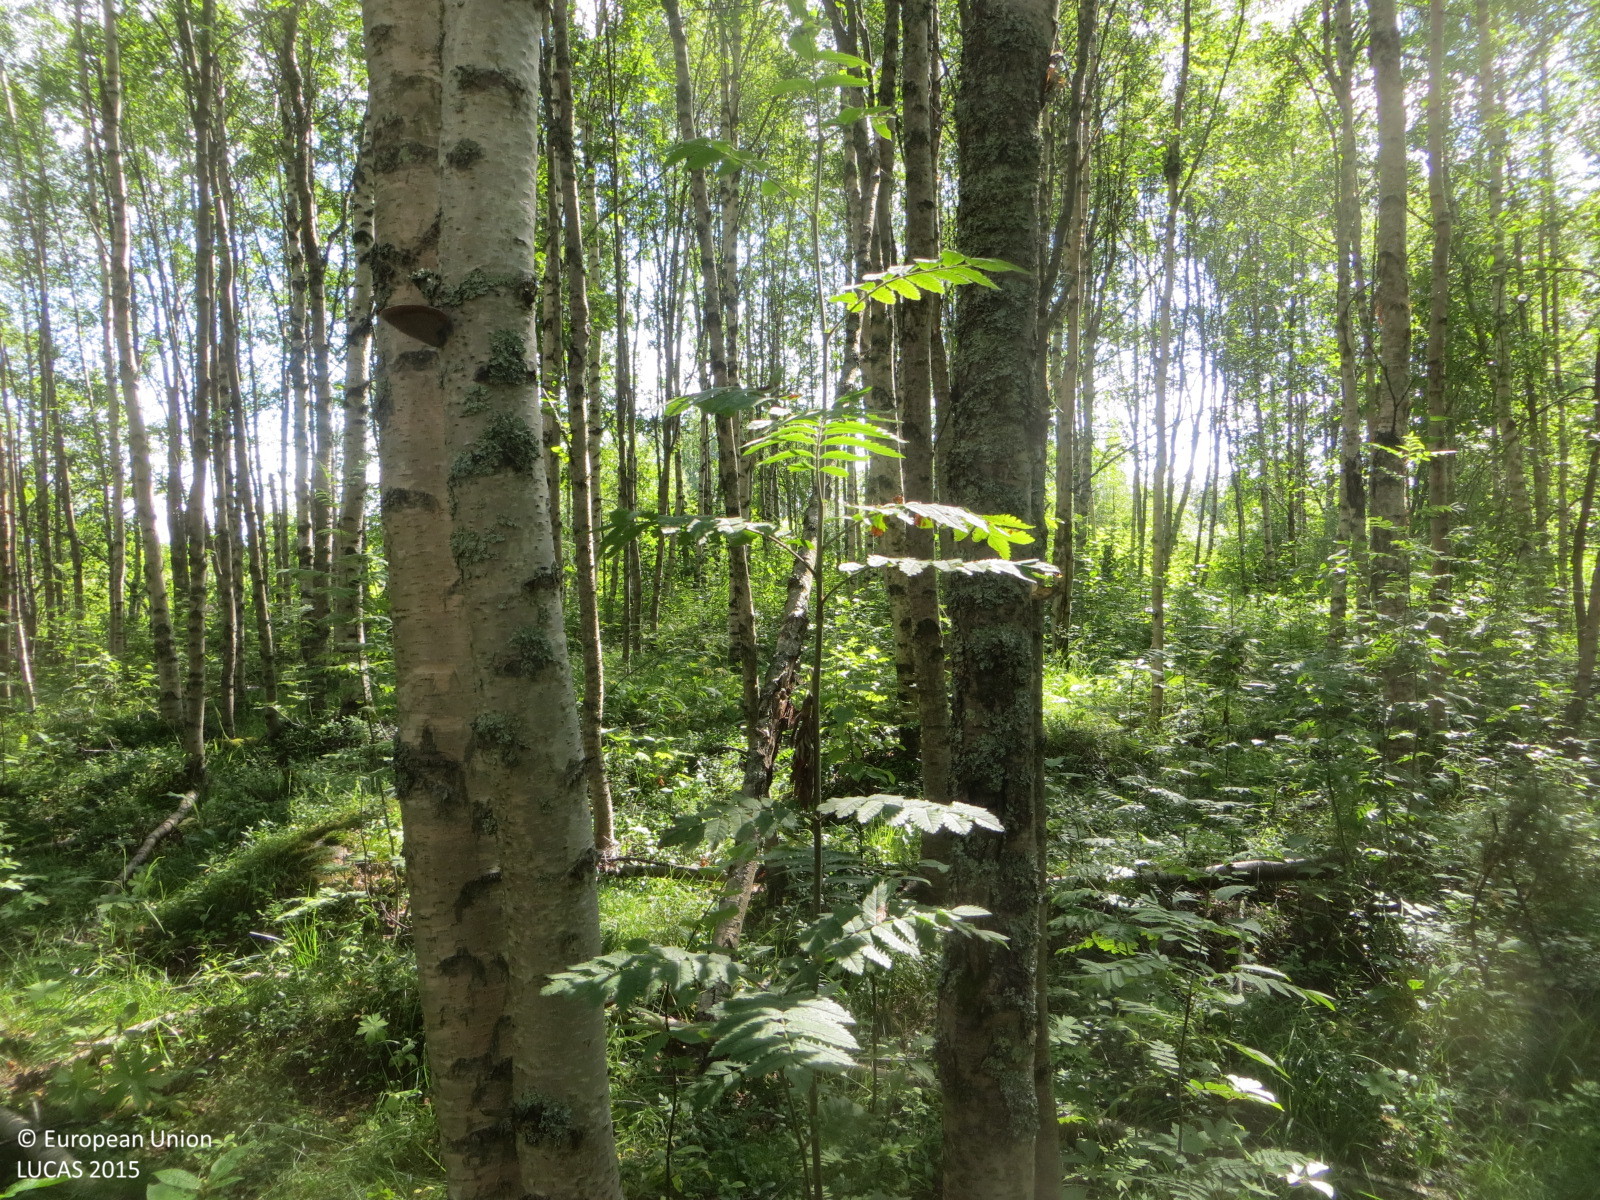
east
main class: Woodland
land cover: Broadleaved woodland
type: boreal forest
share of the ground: > 75 %
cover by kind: broadleaved forest trees 85 %, herbaceous plants 10 %, shrubs 5 %
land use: Forestry
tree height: > 5 m
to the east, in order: Broadleaved woodland; Ditches and canals; Grass margins; Paved roads, cycling and walking lanes; Grassland with sparse tree/shrub cover; Paved roads, cycling and walking lanes; Grassland with sparse tree/shrub cover; Ditches and canals; Broadleaved woodland; Electric lines; Tracks; Grass margins; Broadleaved woodland; Grassland without tree/shrub cover; Broadleaved woodland
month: July
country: FI
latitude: 65.8369
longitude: 24.2134
